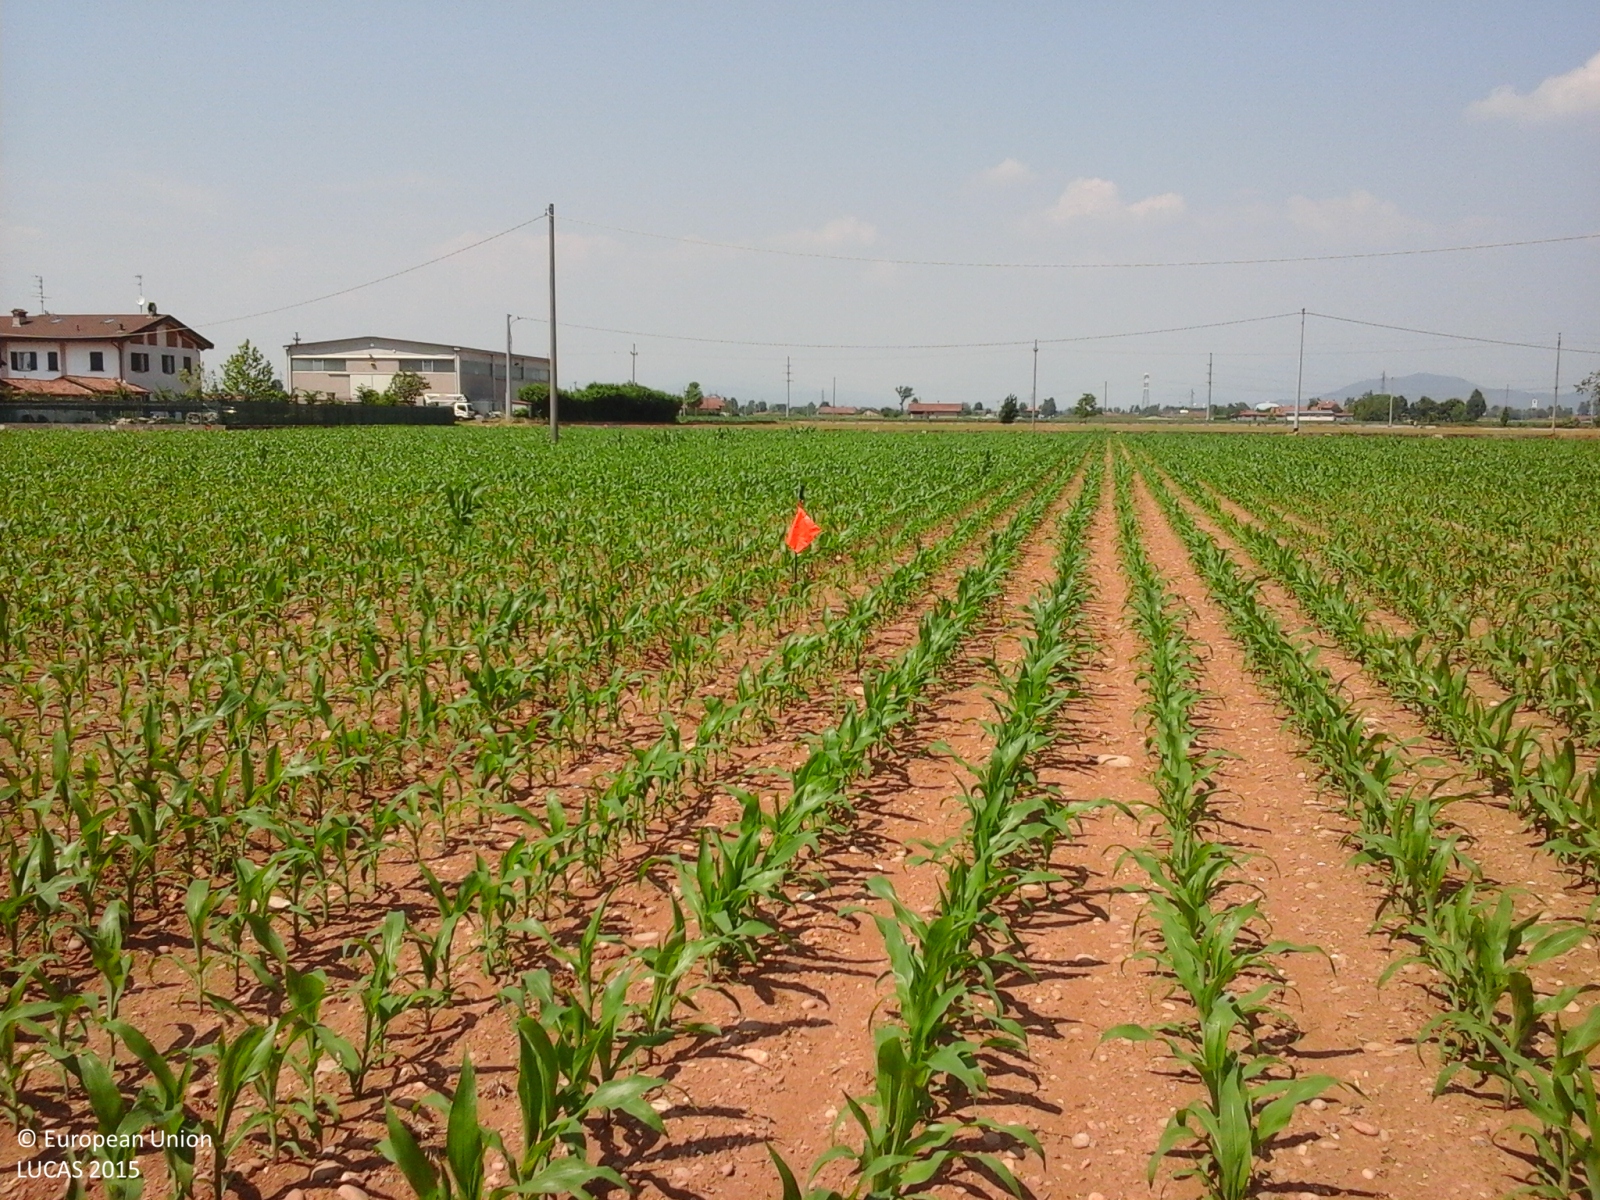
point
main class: Cropland
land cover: Maize
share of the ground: 50 - 75 %
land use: Agriculture (excluding fallow land and kitchen gardens)
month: June
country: IT
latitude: 45.5044
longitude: 9.9106
